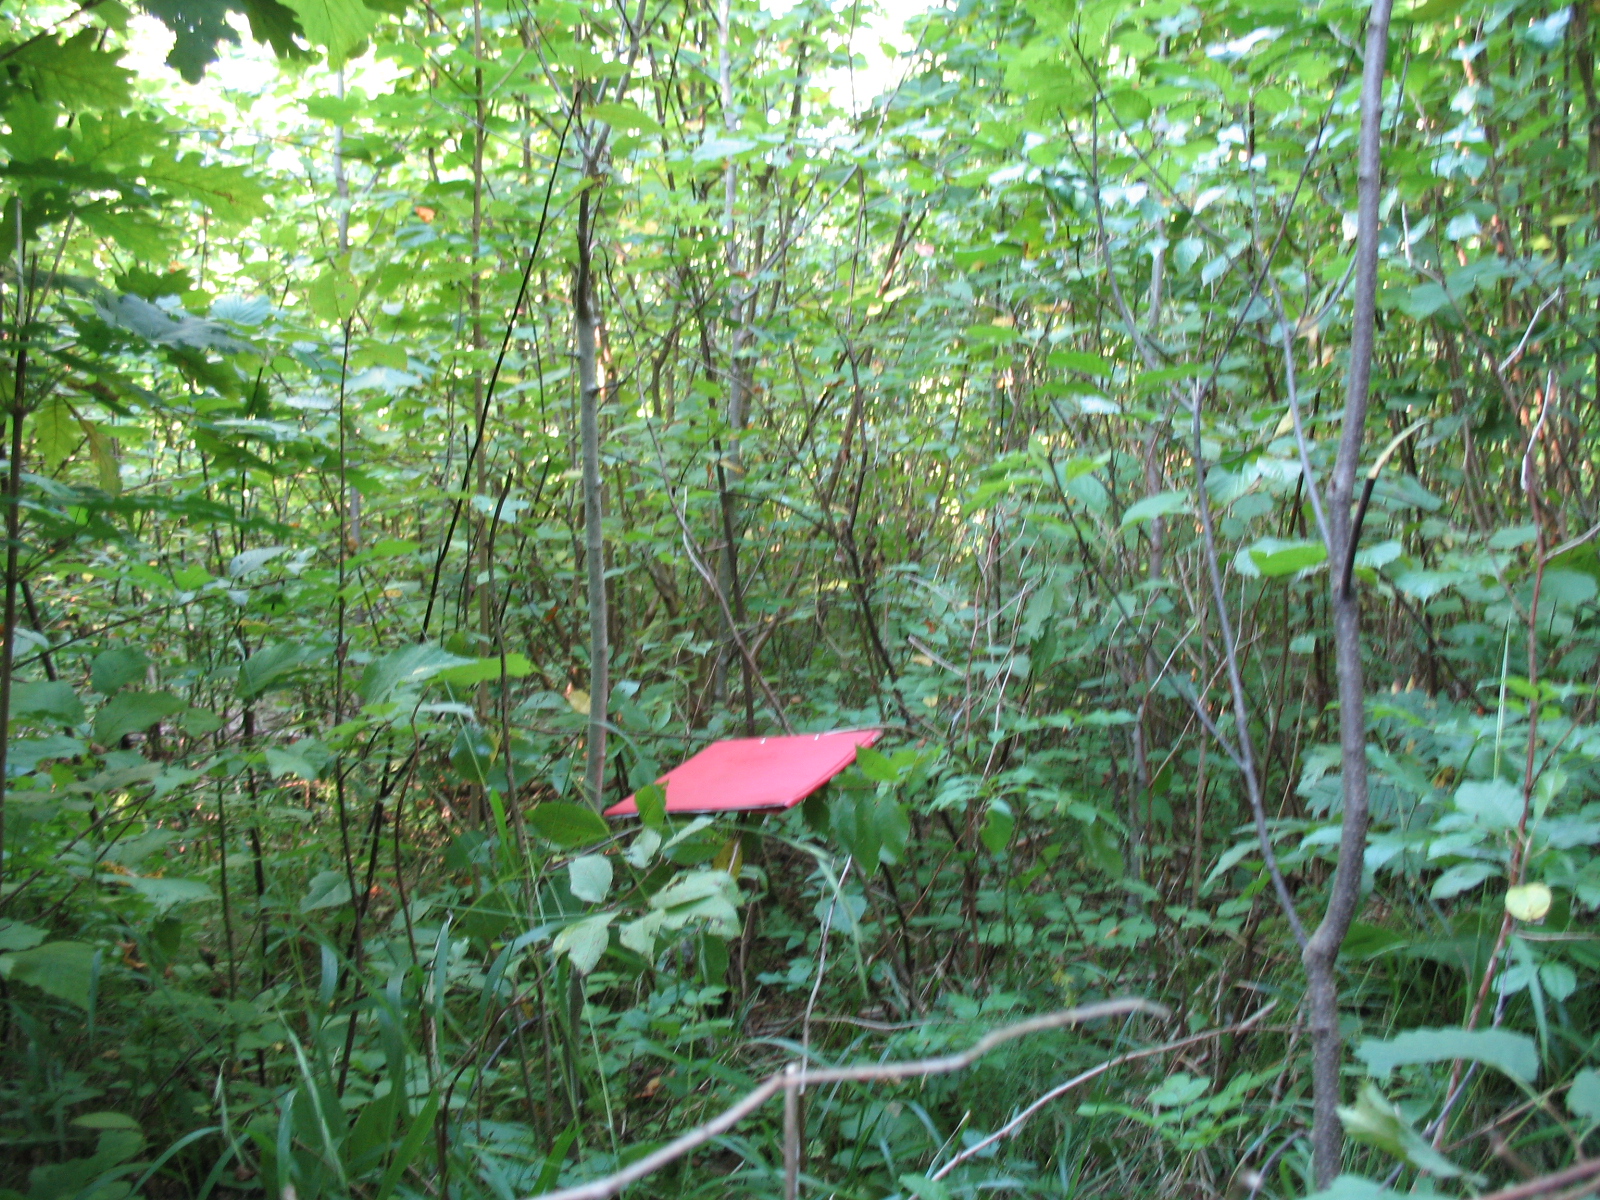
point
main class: Woodland
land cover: Broadleaved woodland
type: non-riverine alder, birch or aspen forest
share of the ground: > 75 %
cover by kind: broadleaved forest trees 90 %, shrubs 5 %, herbaceous plants 5 %
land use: Forestry
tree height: > 5 m
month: August
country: LV
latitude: 56.6061
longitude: 25.7157
